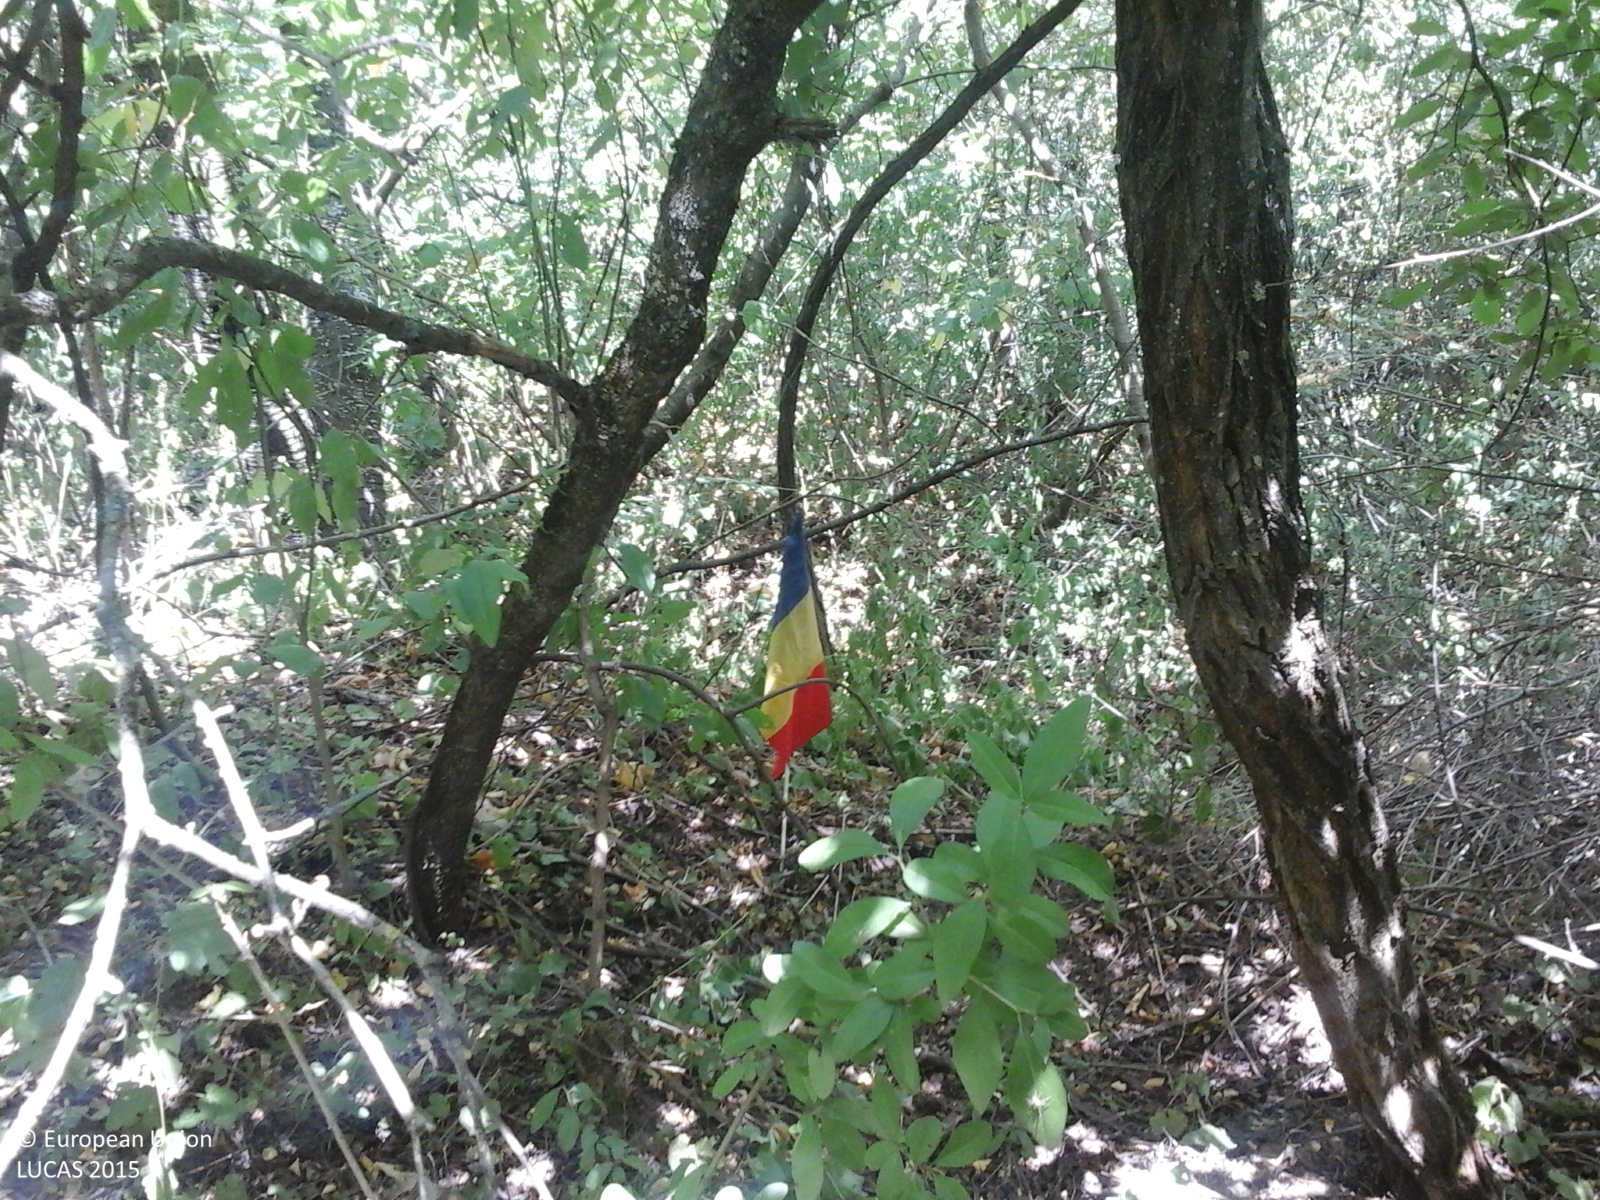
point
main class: Woodland
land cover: Broadleaved woodland
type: mesophytic deciduous forest
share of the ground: > 75 %
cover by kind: broadleaved forest trees 85 %, shrubs 10 %, herbaceous plants 5 %
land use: Forestry
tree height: > 5 m
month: July
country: RO
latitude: 46.2737
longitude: 27.6179
